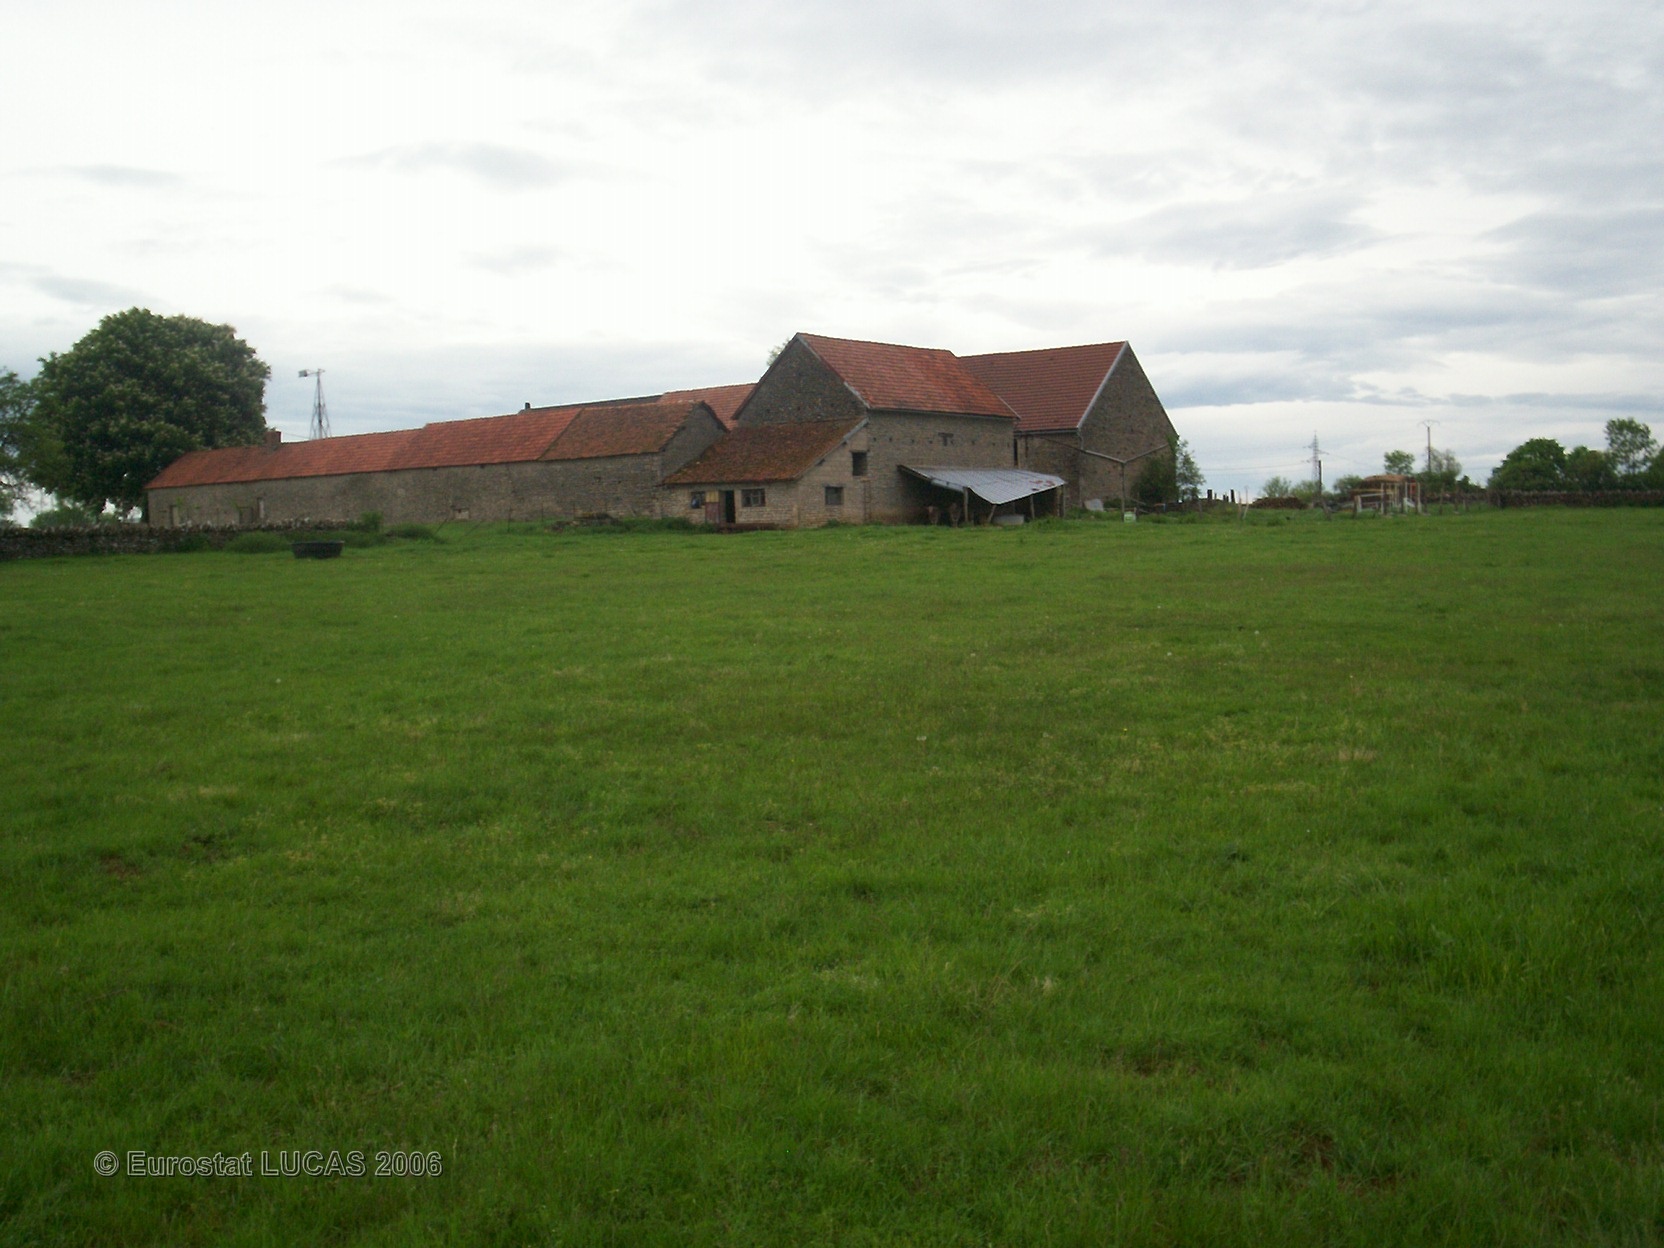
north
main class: Grassland
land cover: Grassland without tree/shrub cover
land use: Agriculture (excluding fallow land and kitchen gardens)
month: May
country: FR
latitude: 47.2805
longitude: 4.6191
